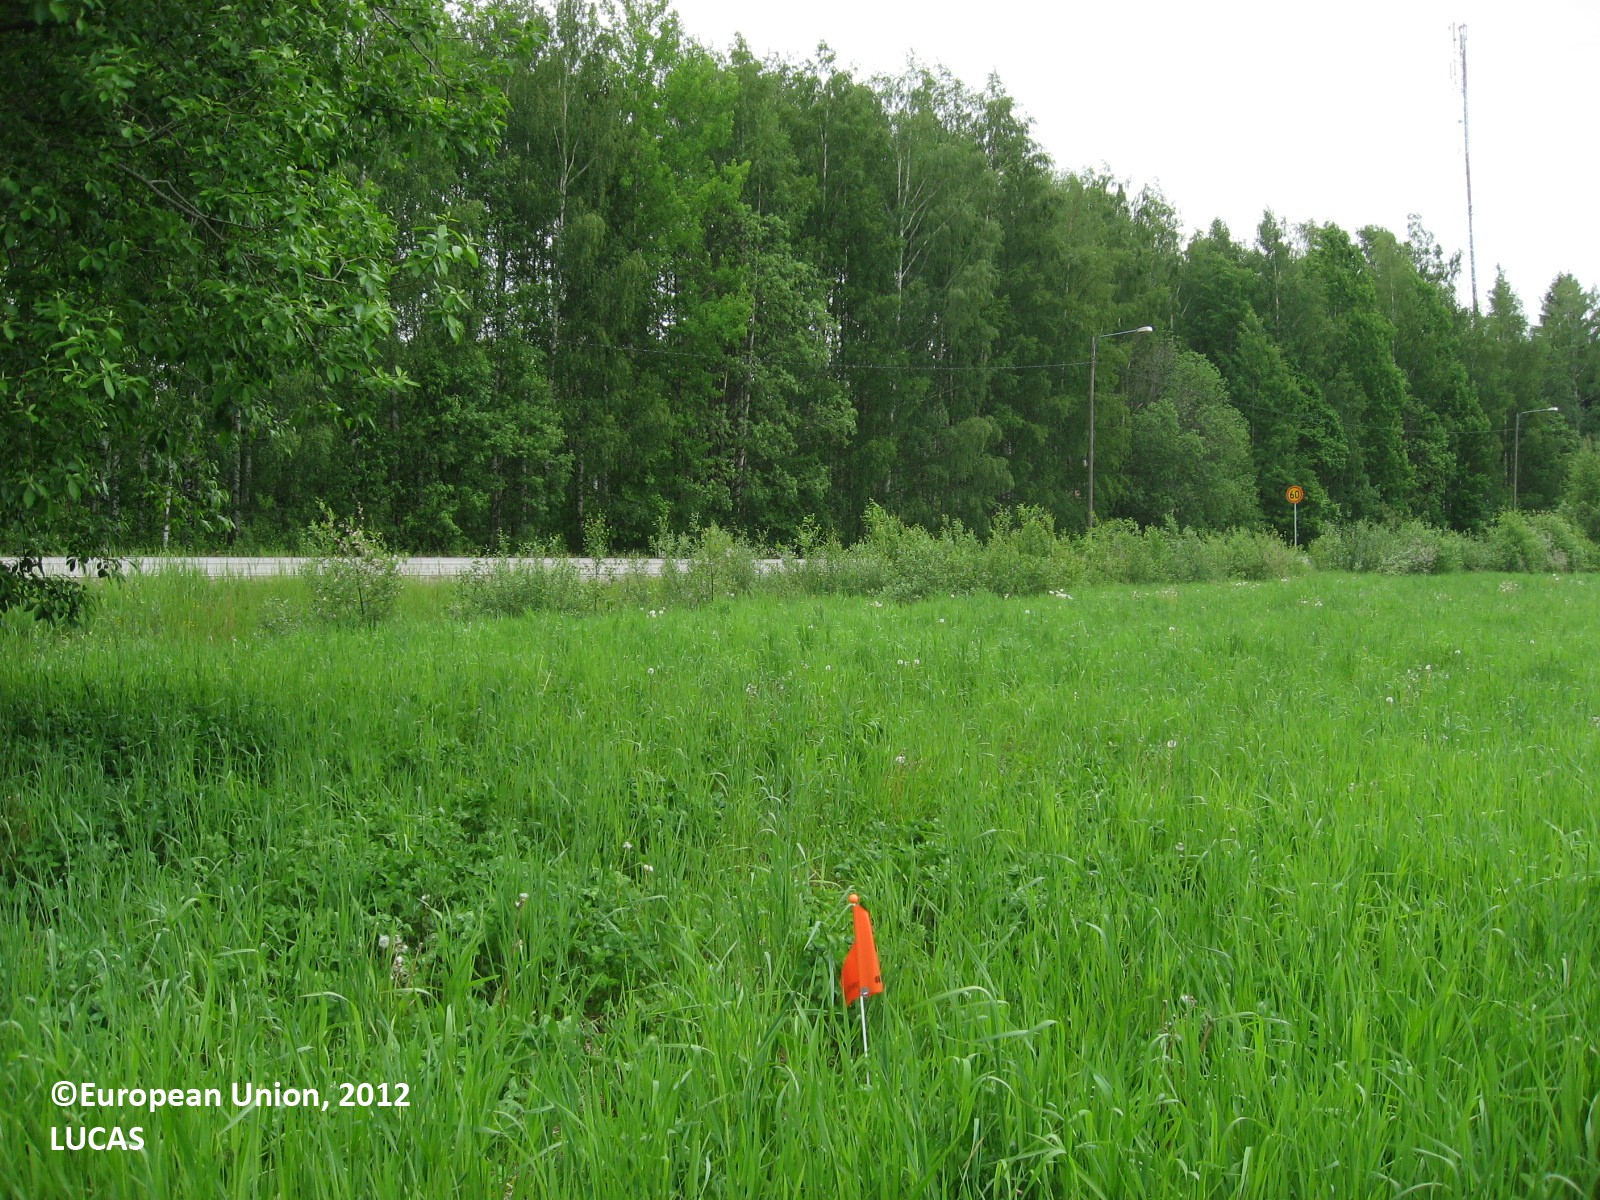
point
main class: Cropland
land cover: Other leguminous and mixtures for fodder
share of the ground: > 75 %
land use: Agriculture (excluding fallow land and kitchen gardens)
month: June
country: FI
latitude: 60.4065
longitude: 24.9481
